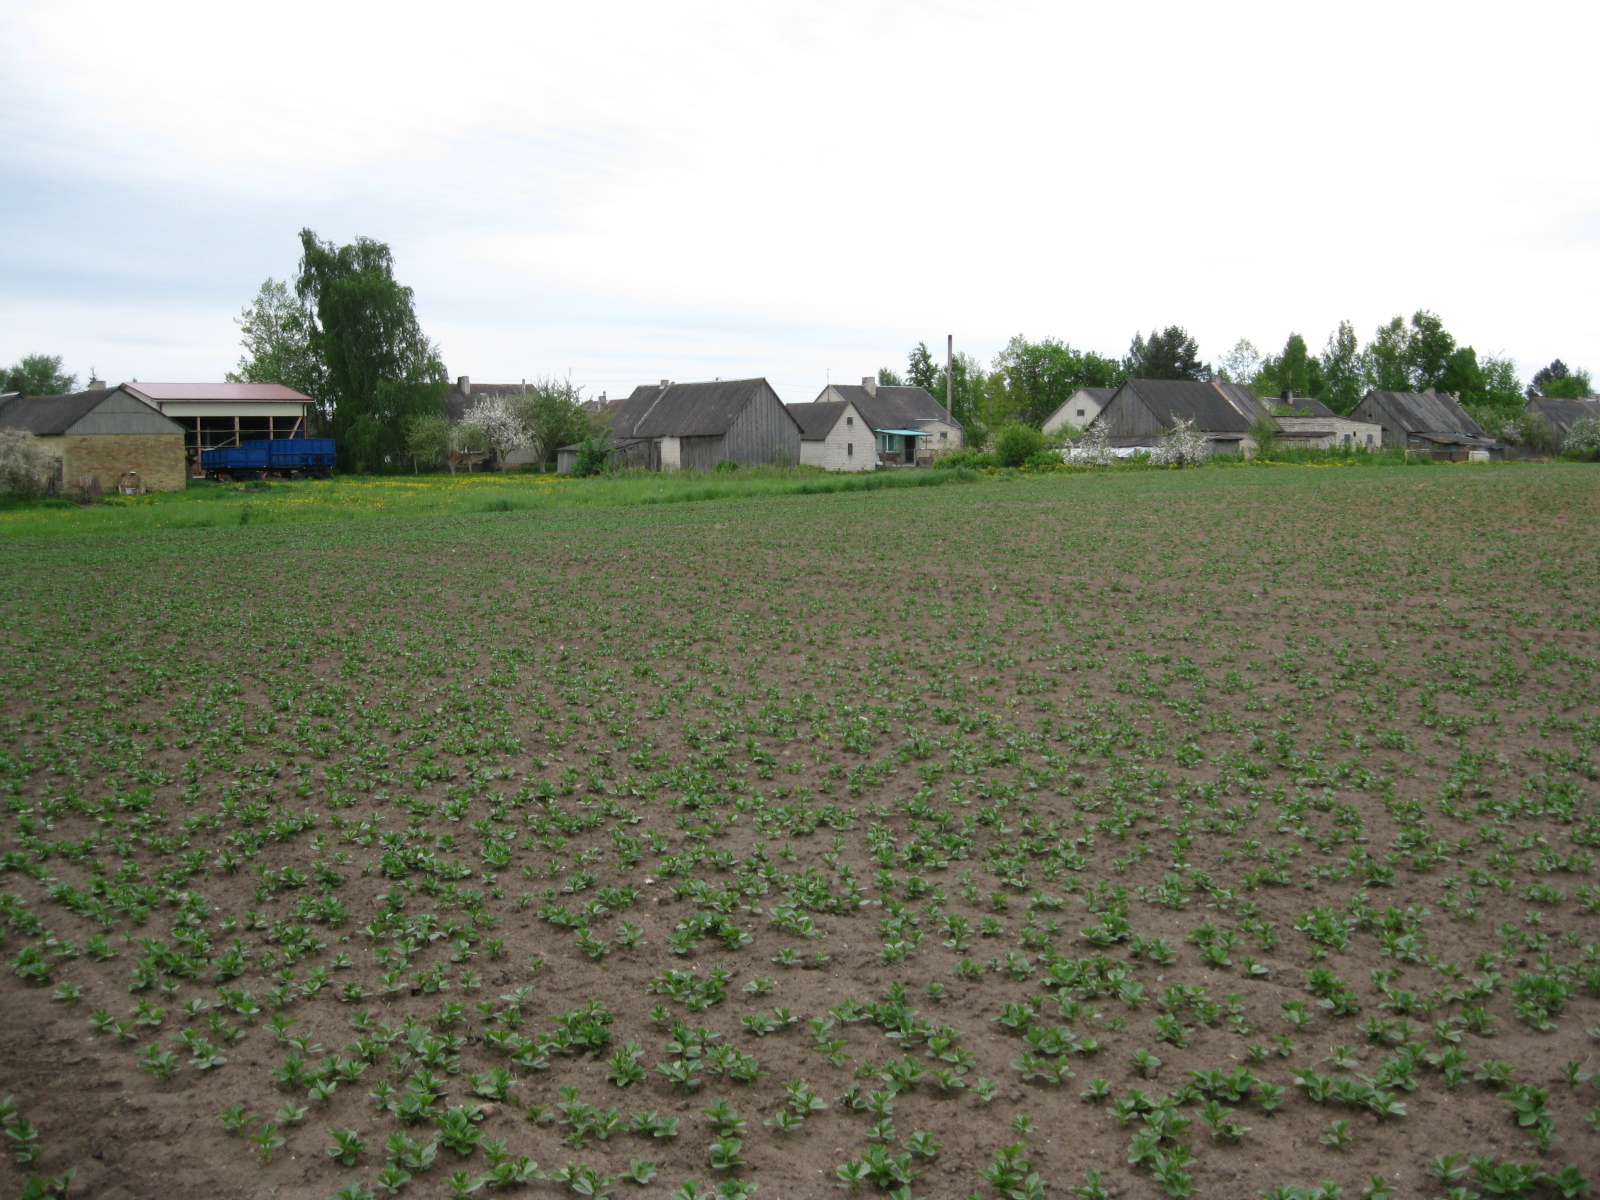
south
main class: Cropland
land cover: Dry pulses
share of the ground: 25 - 50 %
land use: Agriculture (excluding fallow land and kitchen gardens)
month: May
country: LT
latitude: 56.2034
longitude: 23.4712
